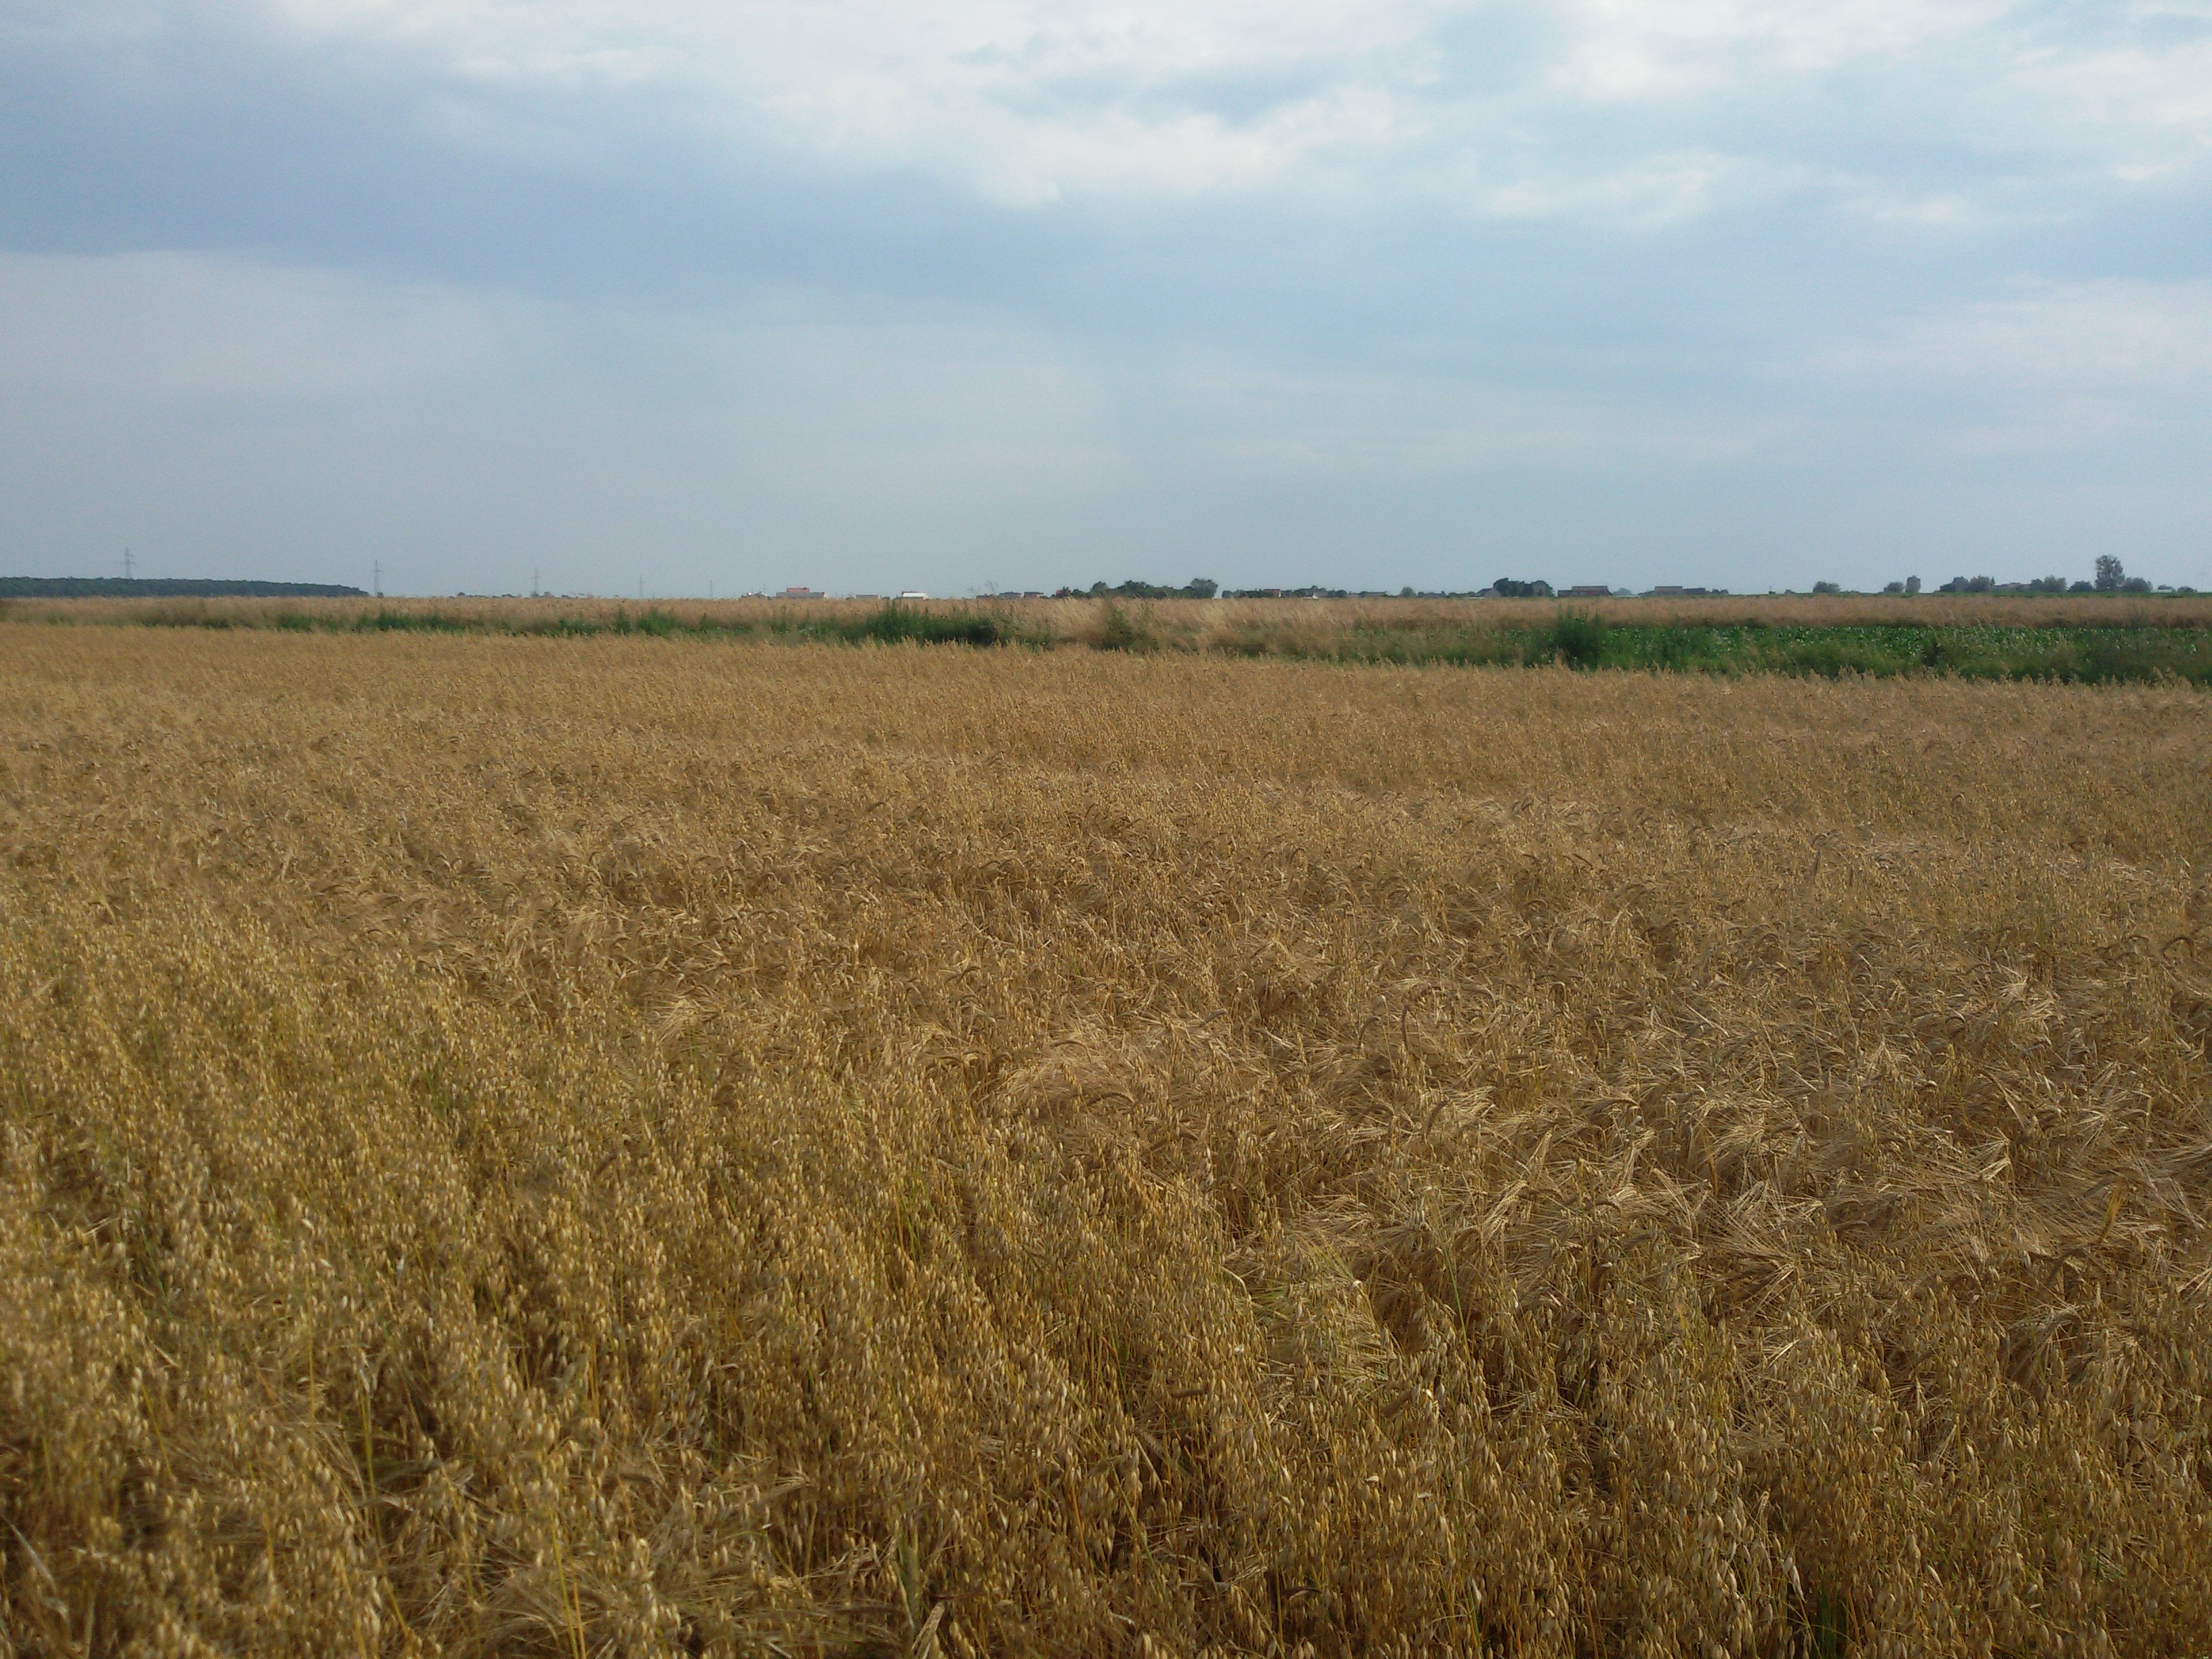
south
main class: Cropland
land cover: Barley
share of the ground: 25 - 50 %
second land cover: Oats
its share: 25 - 50 %
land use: Agriculture (excluding fallow land and kitchen gardens)
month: July
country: PL
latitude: 51.8055
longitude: 17.0733
